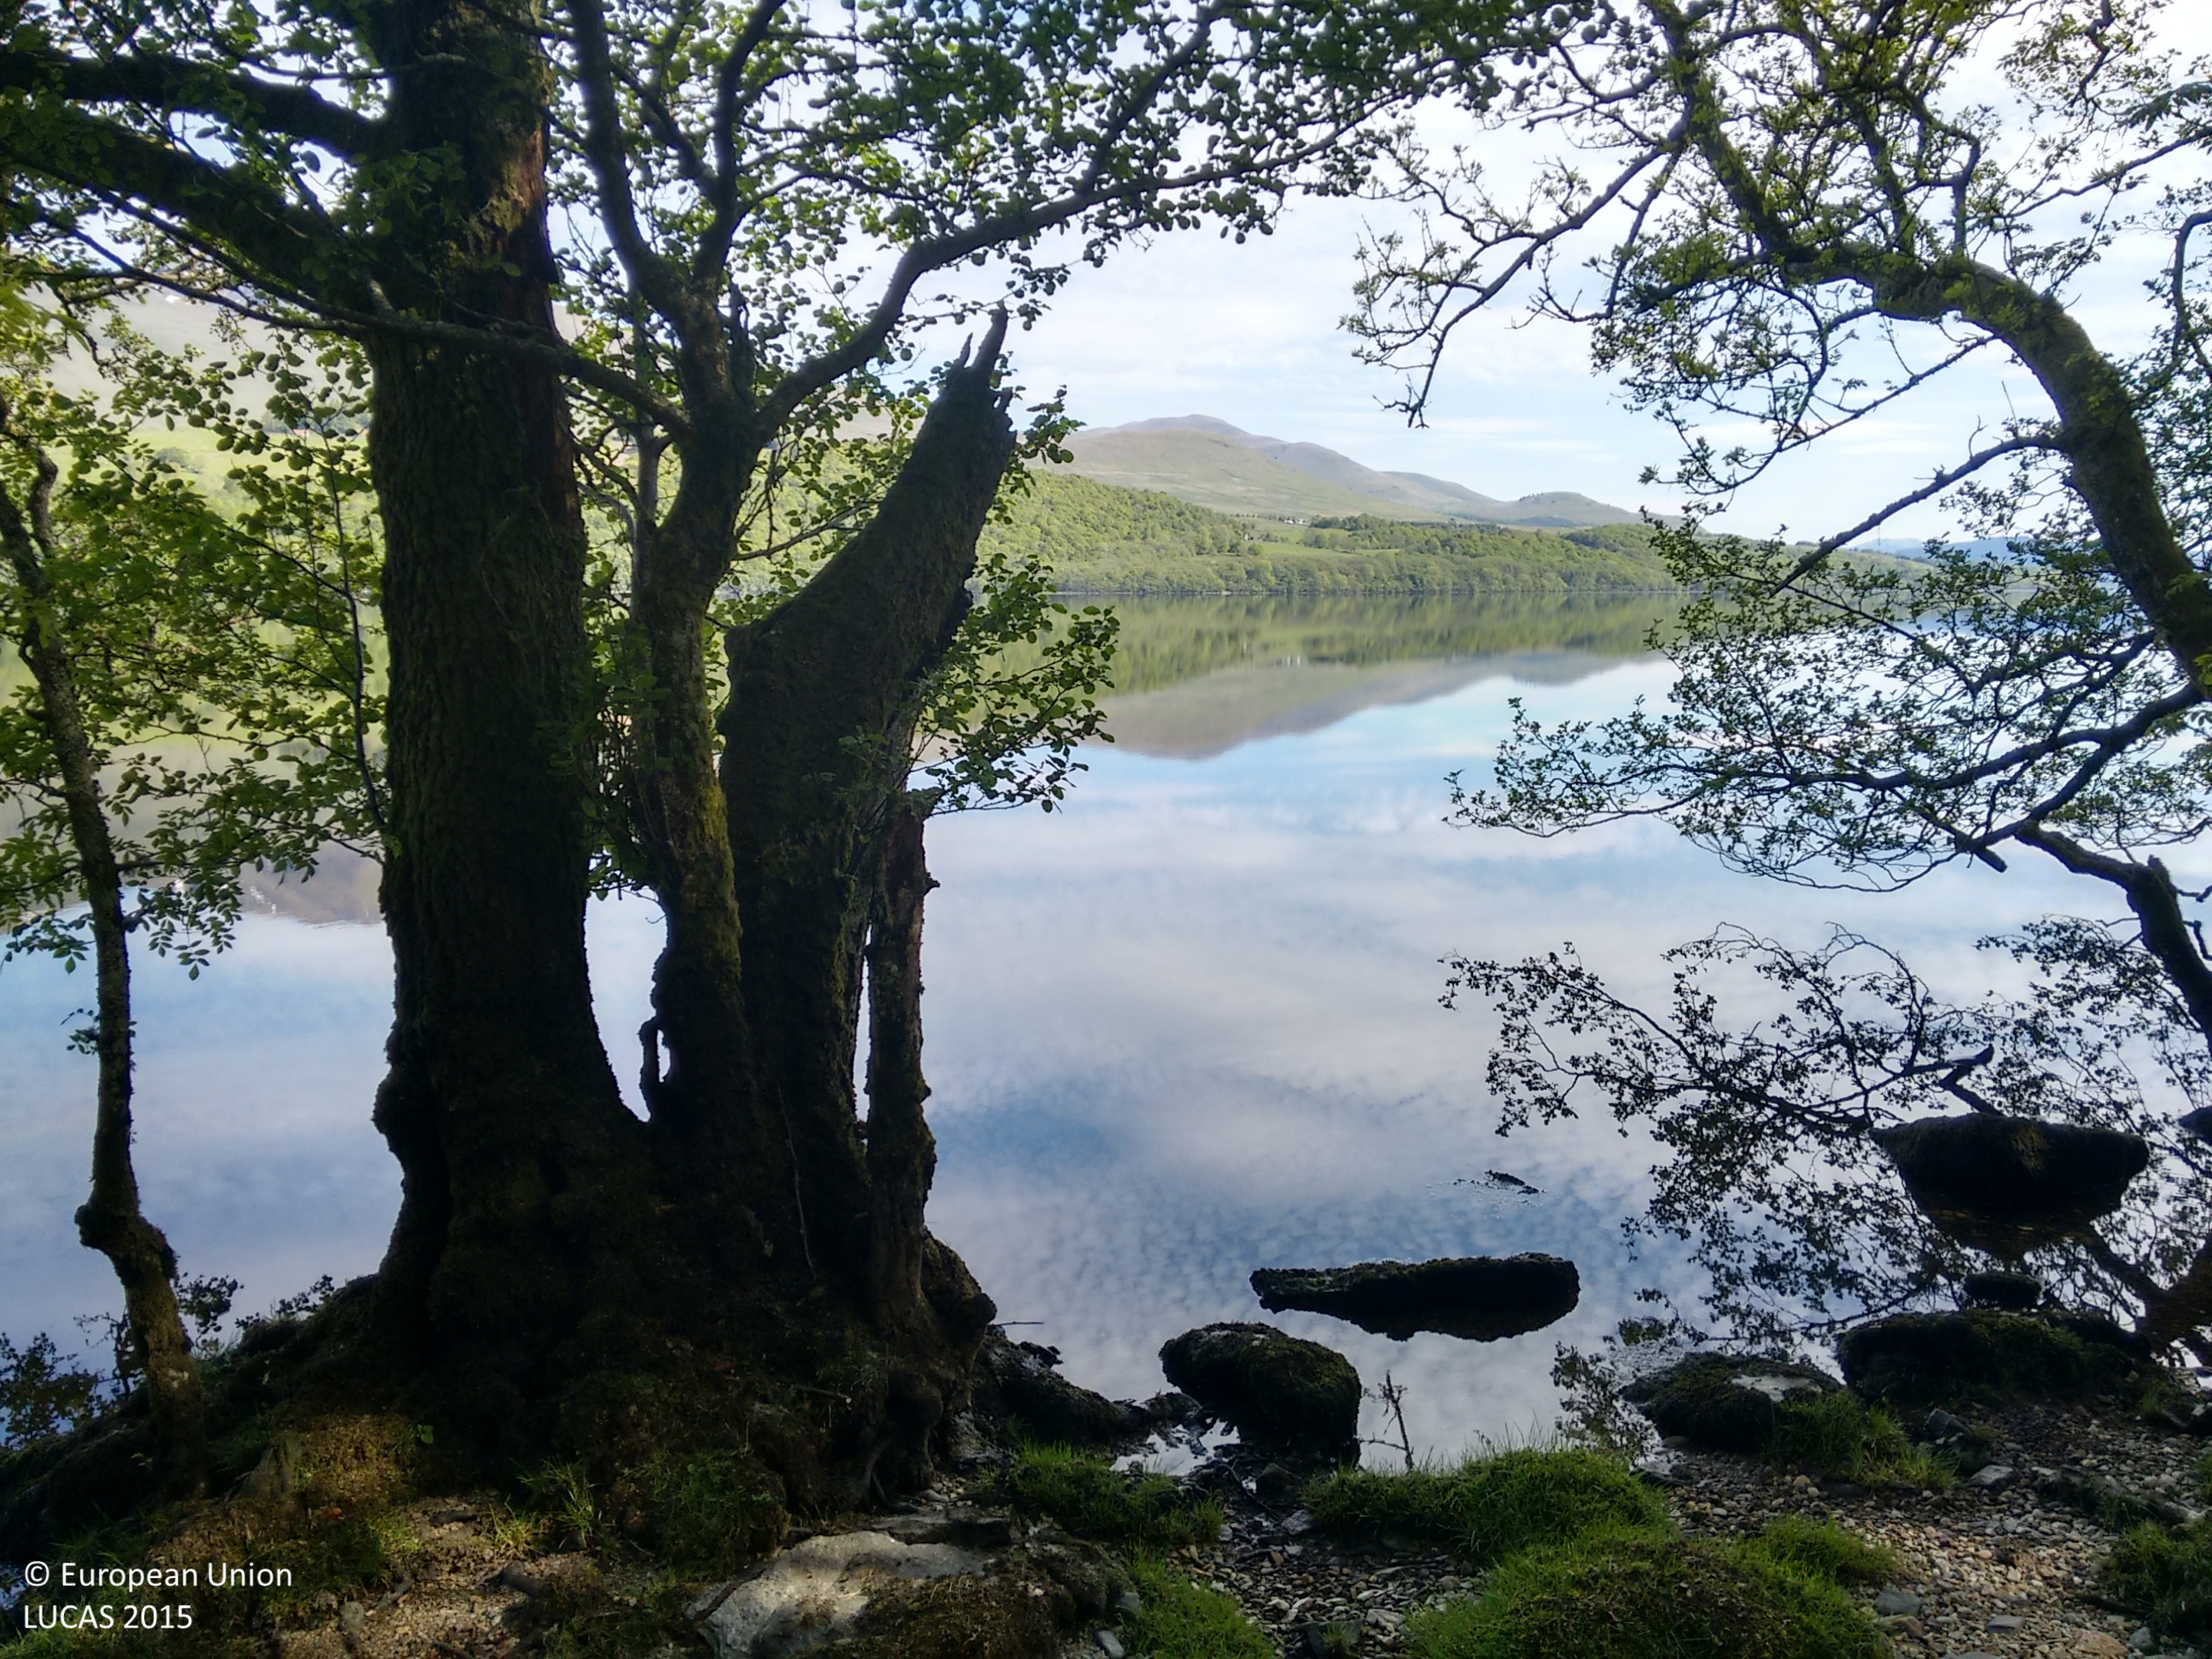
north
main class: Woodland
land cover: Broadleaved woodland
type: mesophytic deciduous forest
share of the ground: > 75 %
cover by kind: broadleaved forest trees 90 %, unconsolidated bare surface 10 %
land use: Agriculture (excluding fallow land and kitchen gardens)
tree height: > 5 m
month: June
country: GB
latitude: 56.4897
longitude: -4.2028
